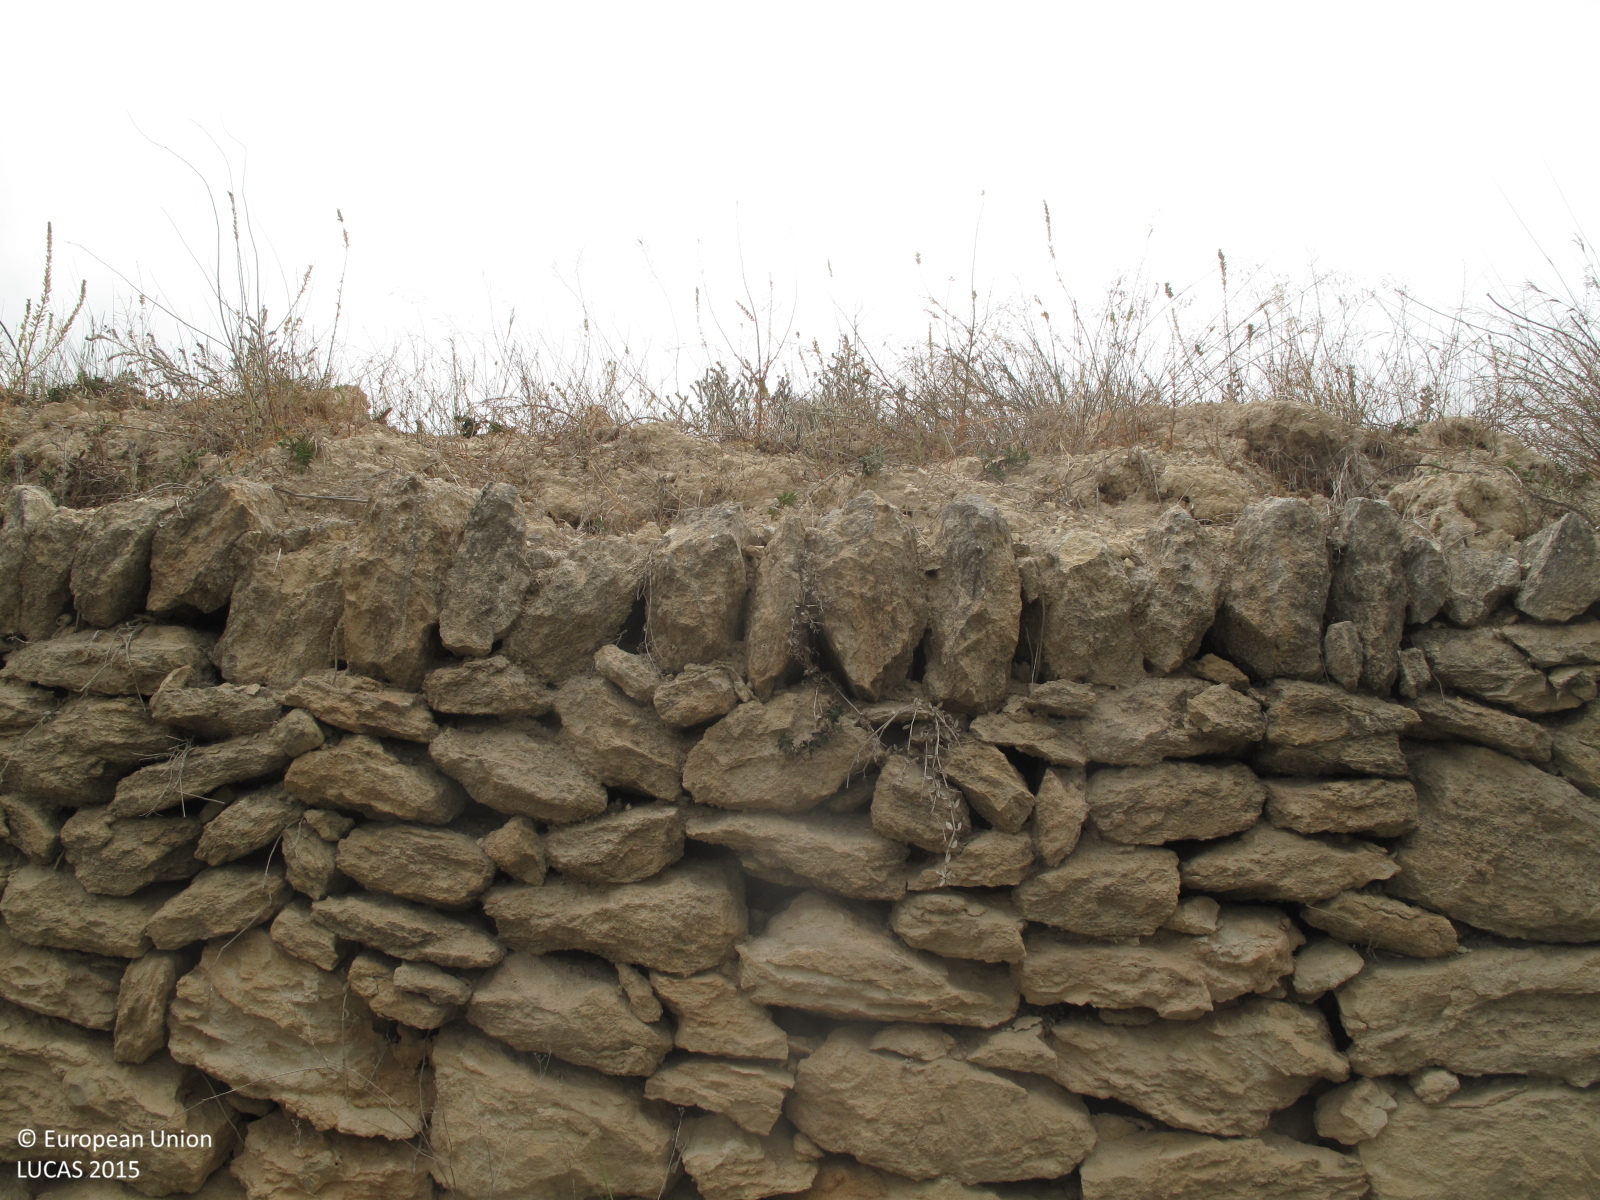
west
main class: Cropland
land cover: Nuts trees
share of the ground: 25 - 50 %
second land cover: Spontaneously vegetated surfaces
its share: > 75 %
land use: Agriculture (excluding fallow land and kitchen gardens)
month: May
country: ES
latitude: 38.7069
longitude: 0.0885
